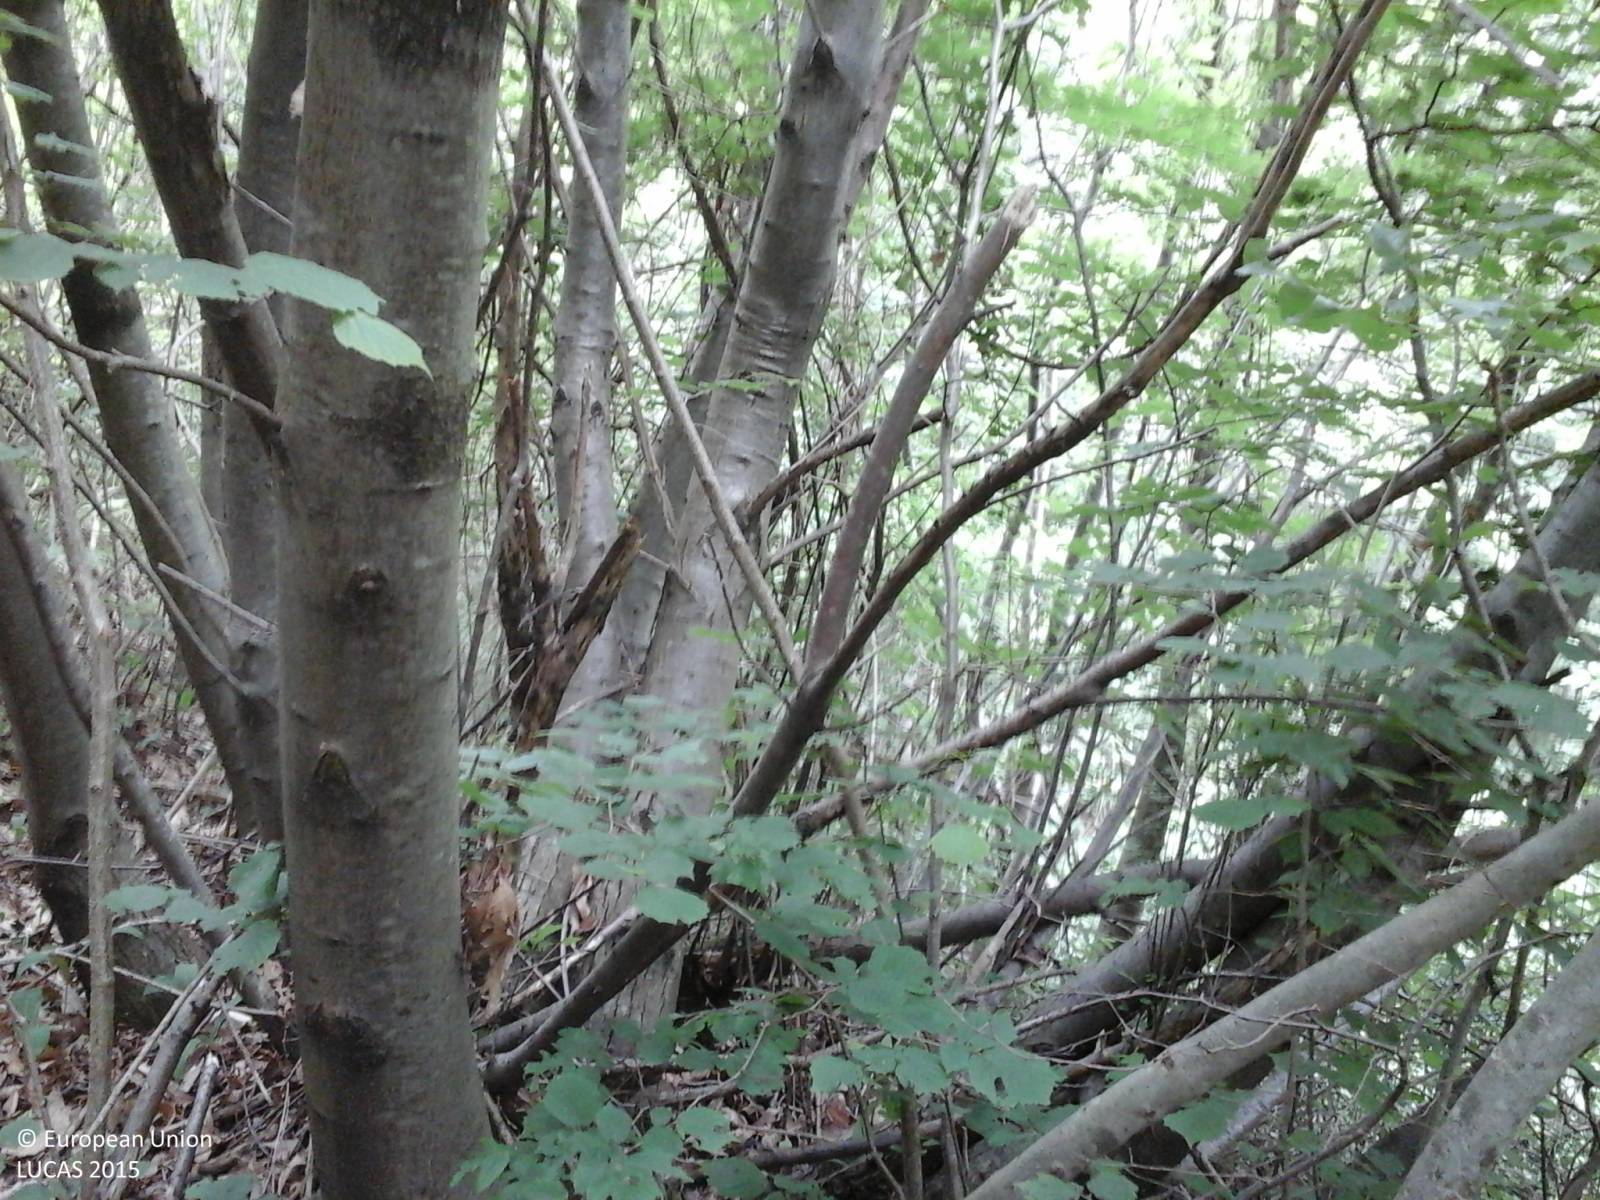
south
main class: Woodland
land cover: Broadleaved woodland
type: thermophilous deciduous forest
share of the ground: > 75 %
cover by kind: broadleaved forest trees 90 %, shrubs 10 %
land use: Forestry
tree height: > 5 m
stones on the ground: 10 - 25 %
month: June
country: IT
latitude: 46.1333
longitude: 13.4524
